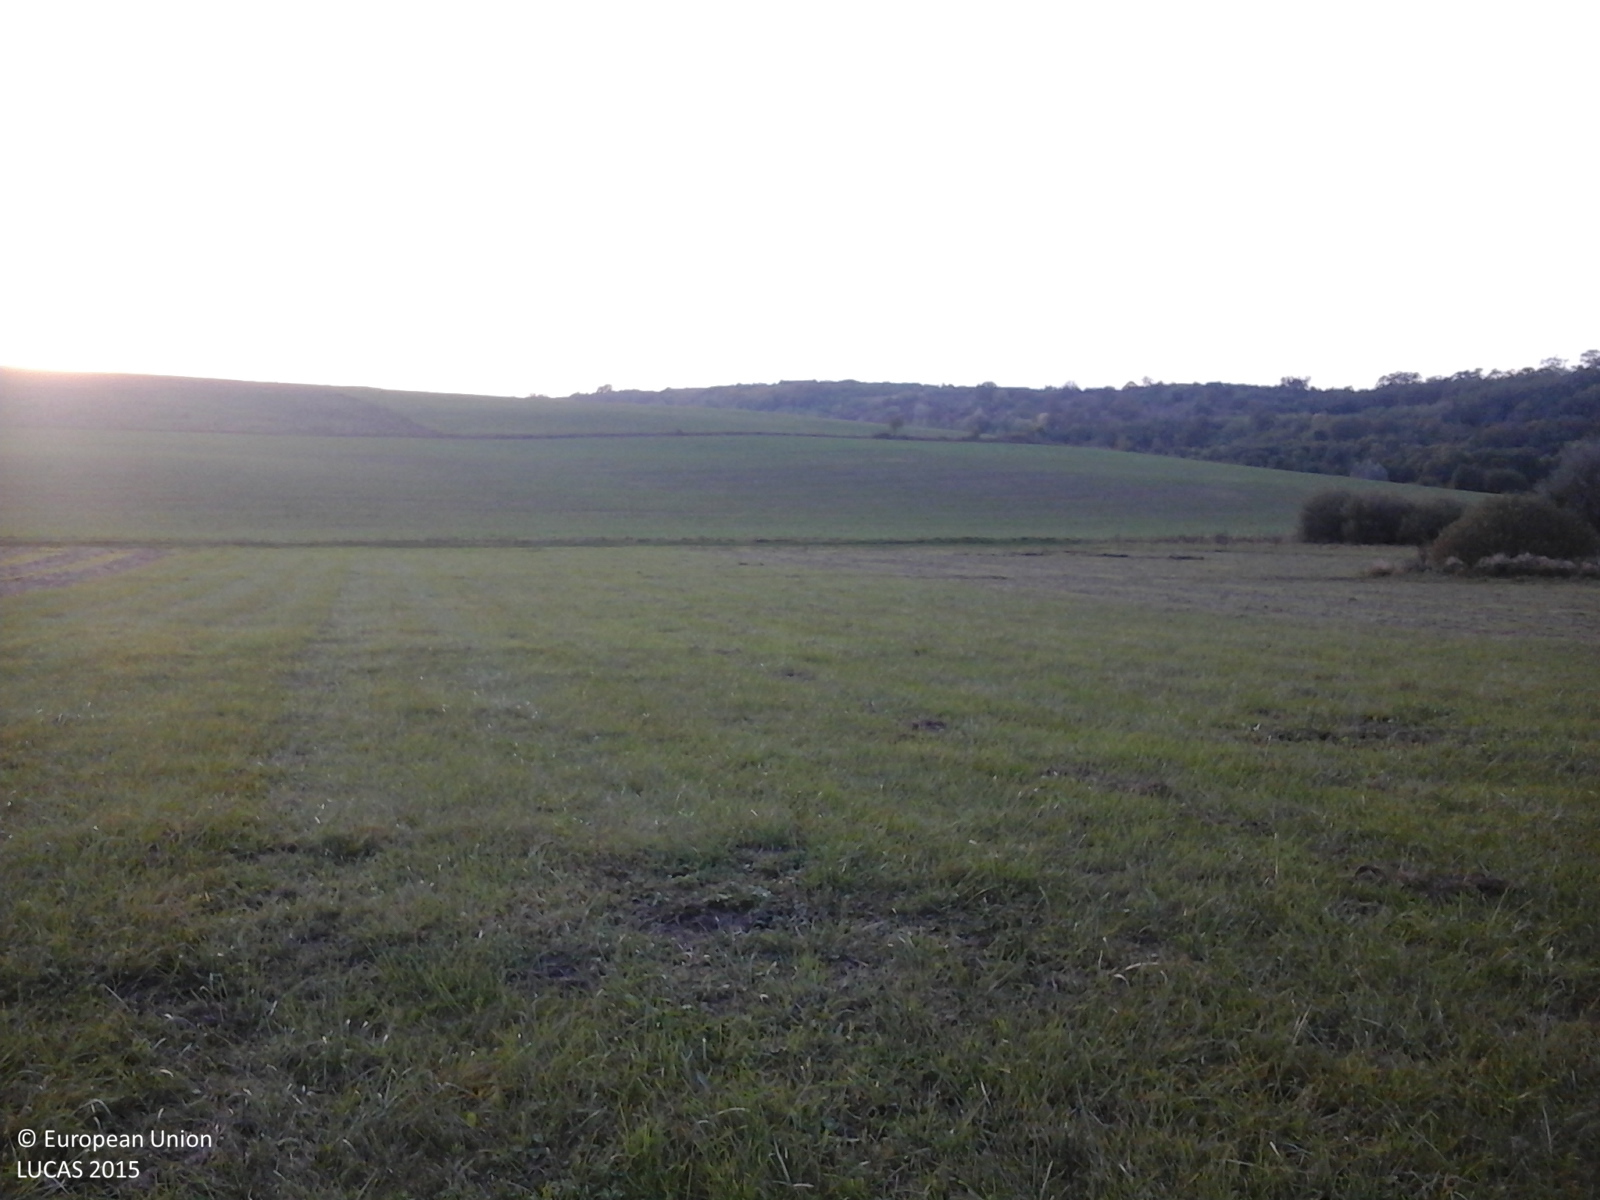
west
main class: Grassland
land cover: Grassland without tree/shrub cover
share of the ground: > 75 %
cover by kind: herbaceous plants 100 %
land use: Agriculture (excluding fallow land and kitchen gardens)
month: October
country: RO
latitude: 46.2845
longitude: 24.2667
